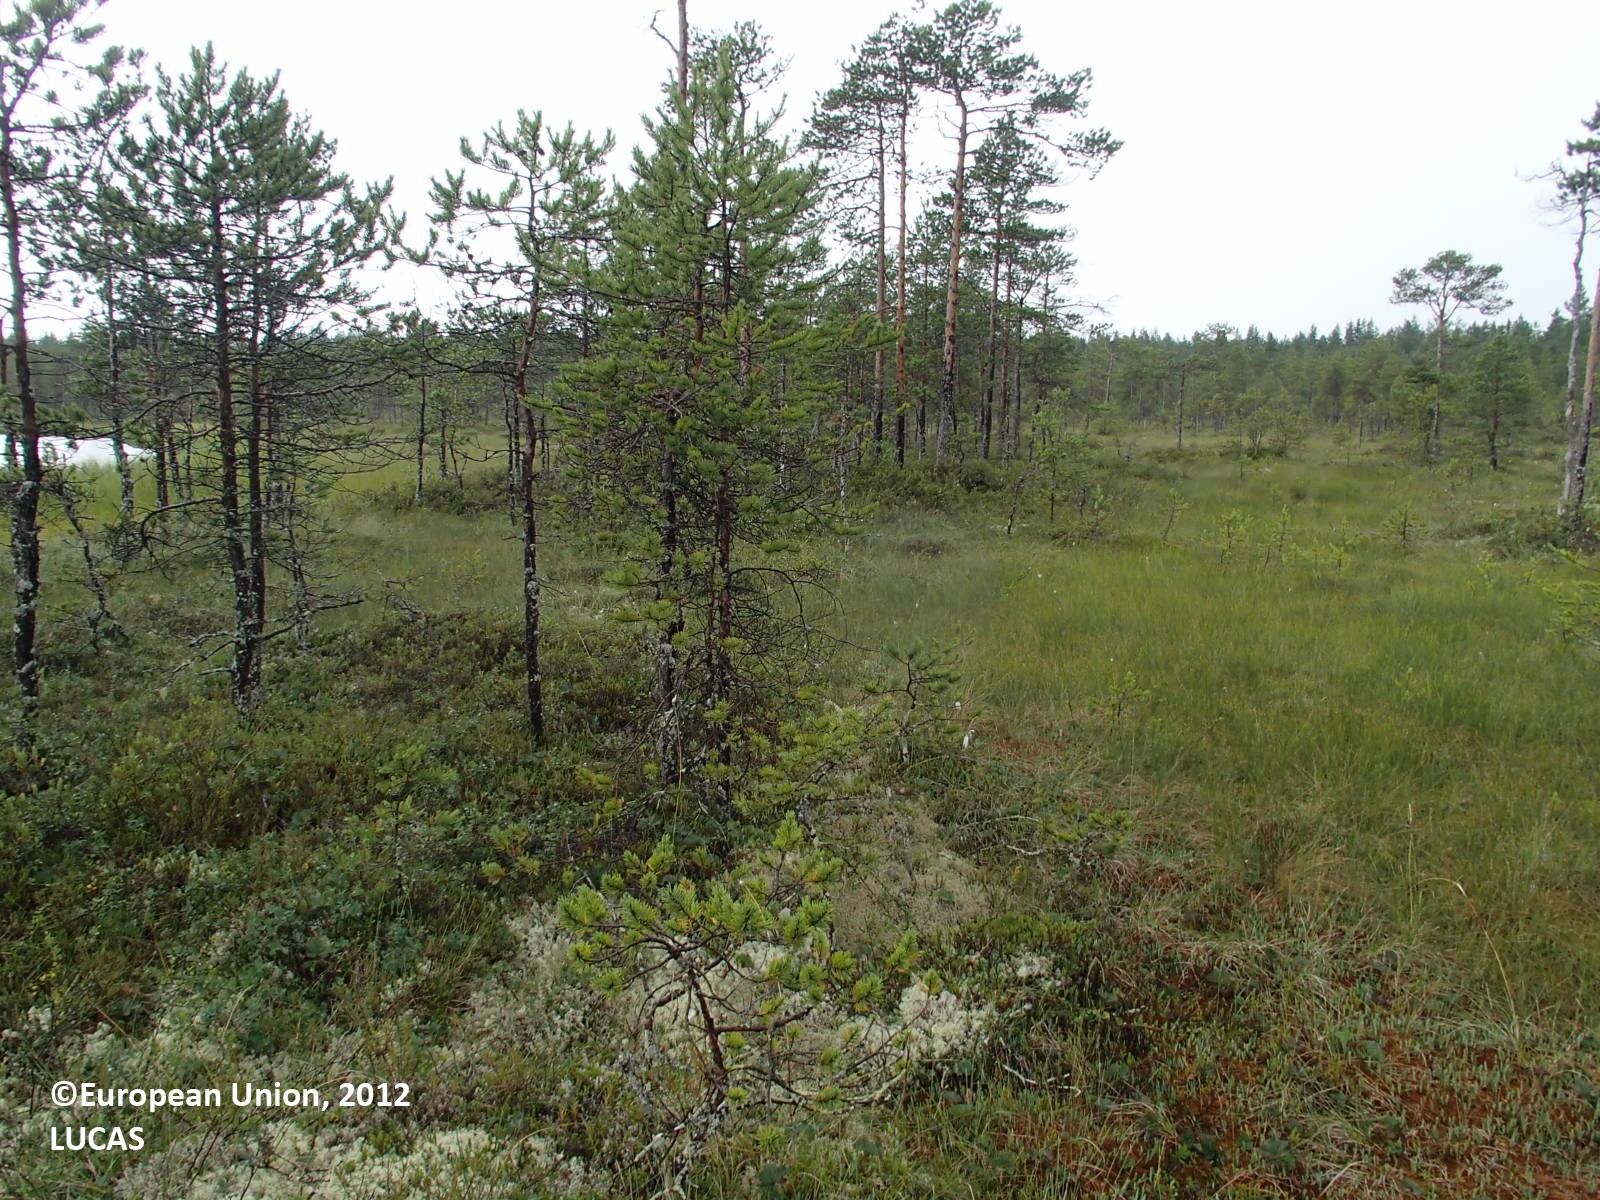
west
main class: Woodland
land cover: Pine dominated coniferous woodland
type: mire and swamp forests
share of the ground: 25 - 50 %
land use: Semi-natural and natural areas not in use
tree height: > 5 m
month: July
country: FI
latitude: 64.2500
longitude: 26.3074
